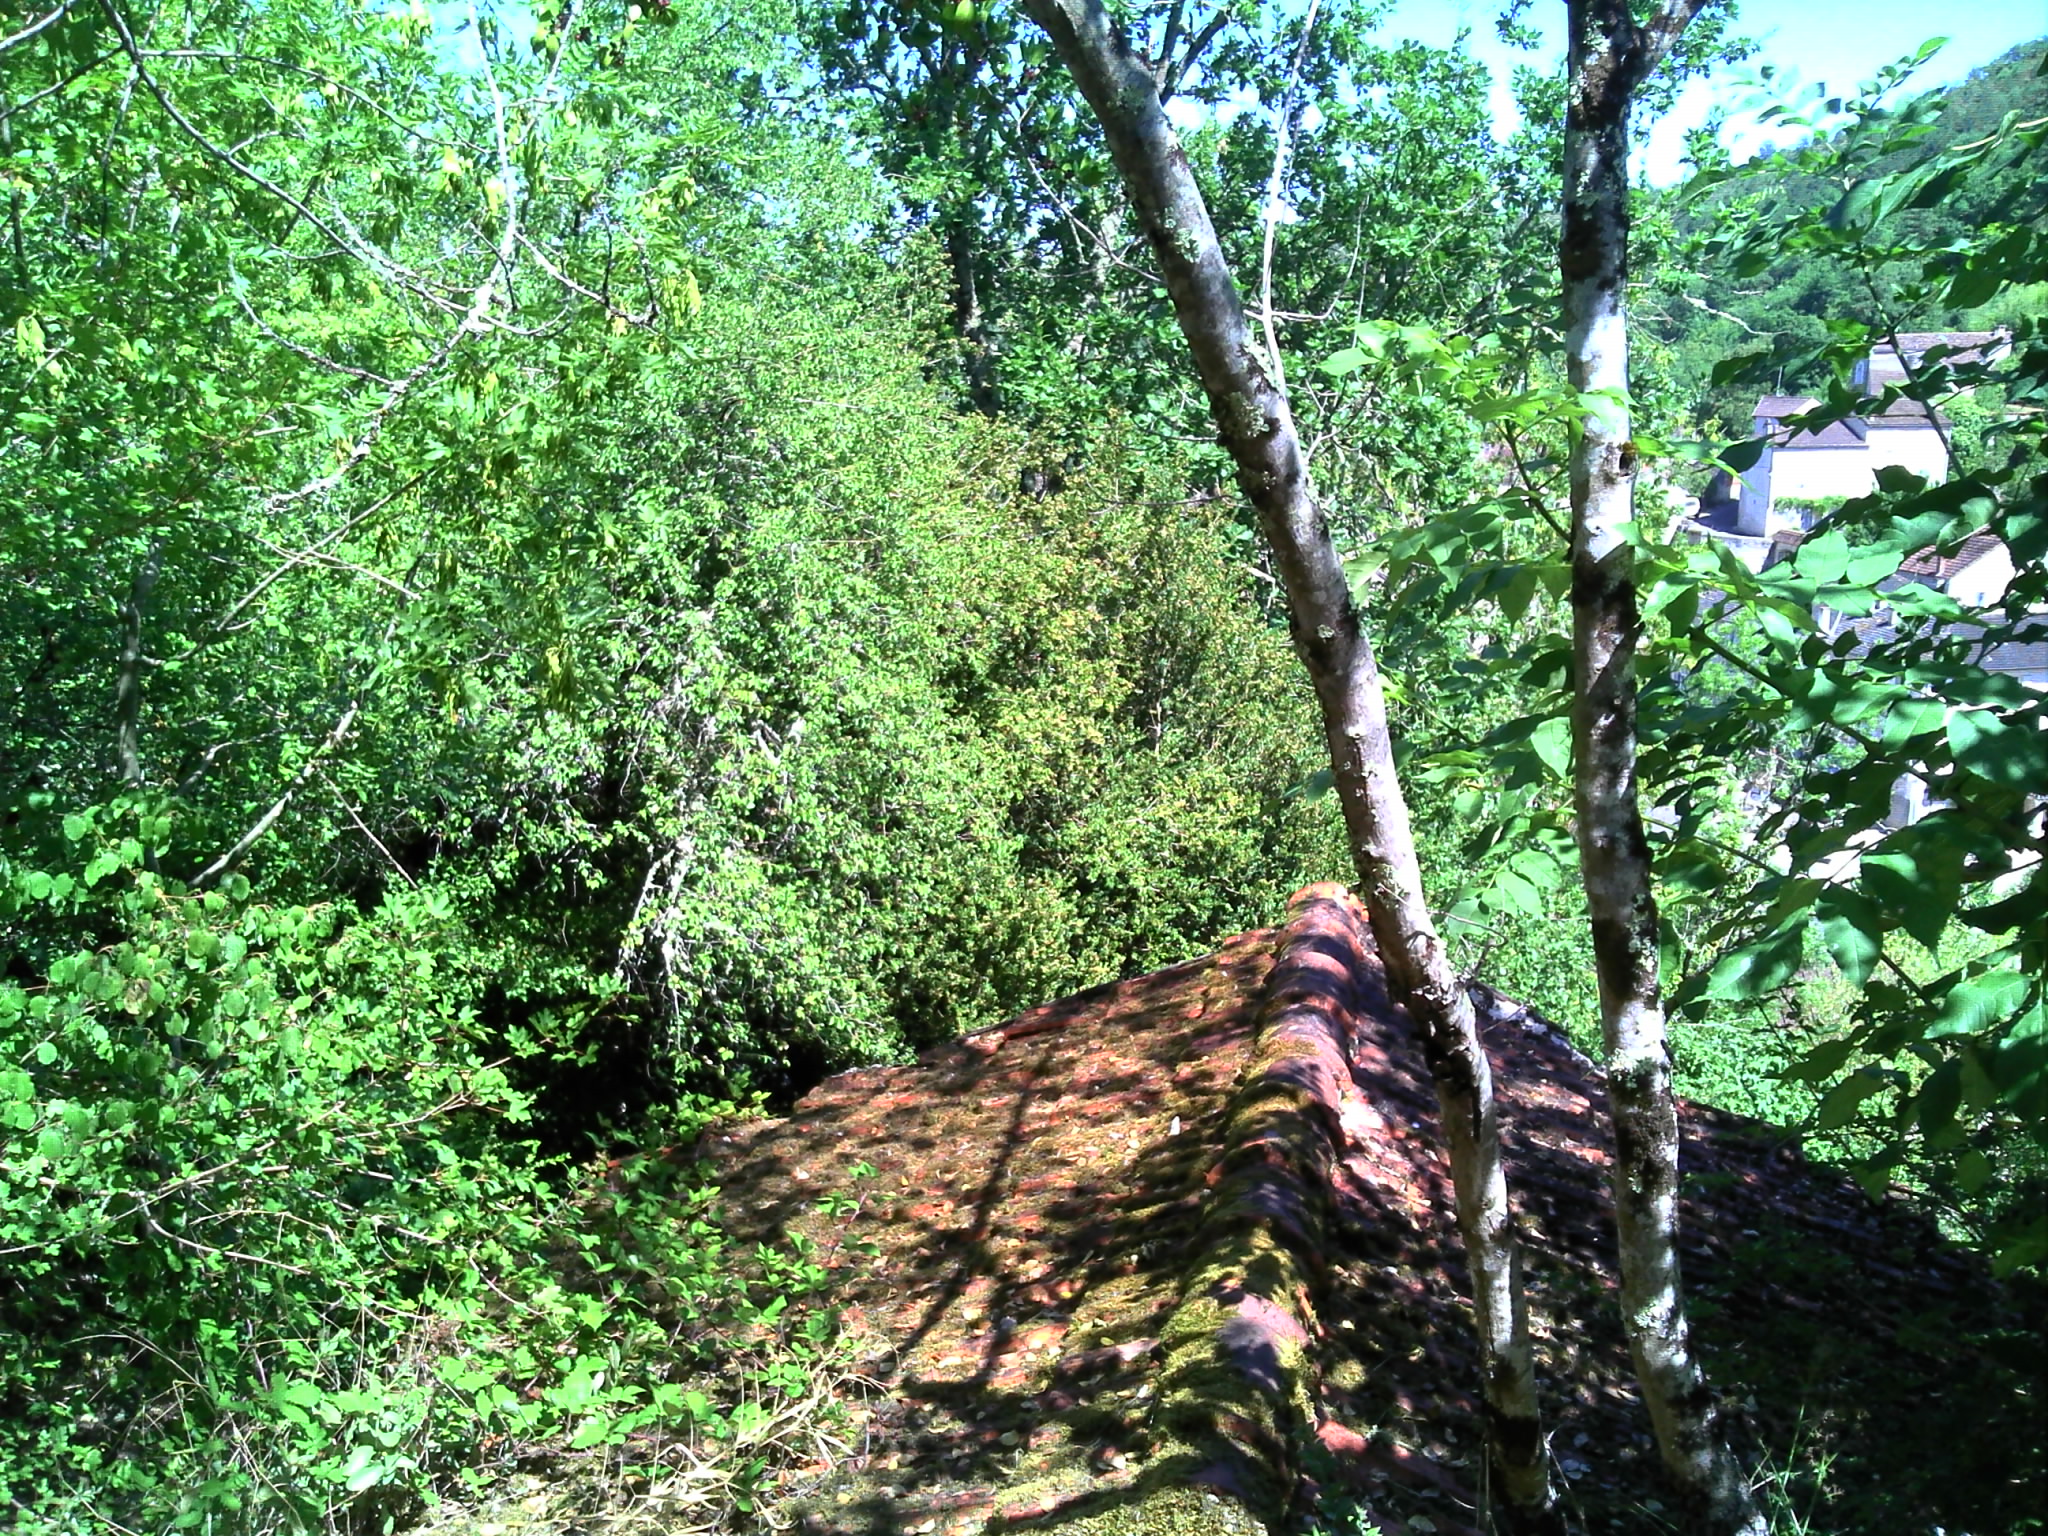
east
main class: Grassland
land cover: Grassland with sparse tree/shrub cover
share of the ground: > 75 %
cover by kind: herbaceous plants 95 %, broadleaved forest trees 5 %
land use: Residential
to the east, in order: Grassland with sparse tree/shrub cover; Broadleaved woodland; Artificial constructions in urban areas; Spontaneously vegetated surfaces; Tracks; Broadleaved woodland; Inland fresh running water
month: July
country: FR
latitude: 44.4687
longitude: 1.2355
